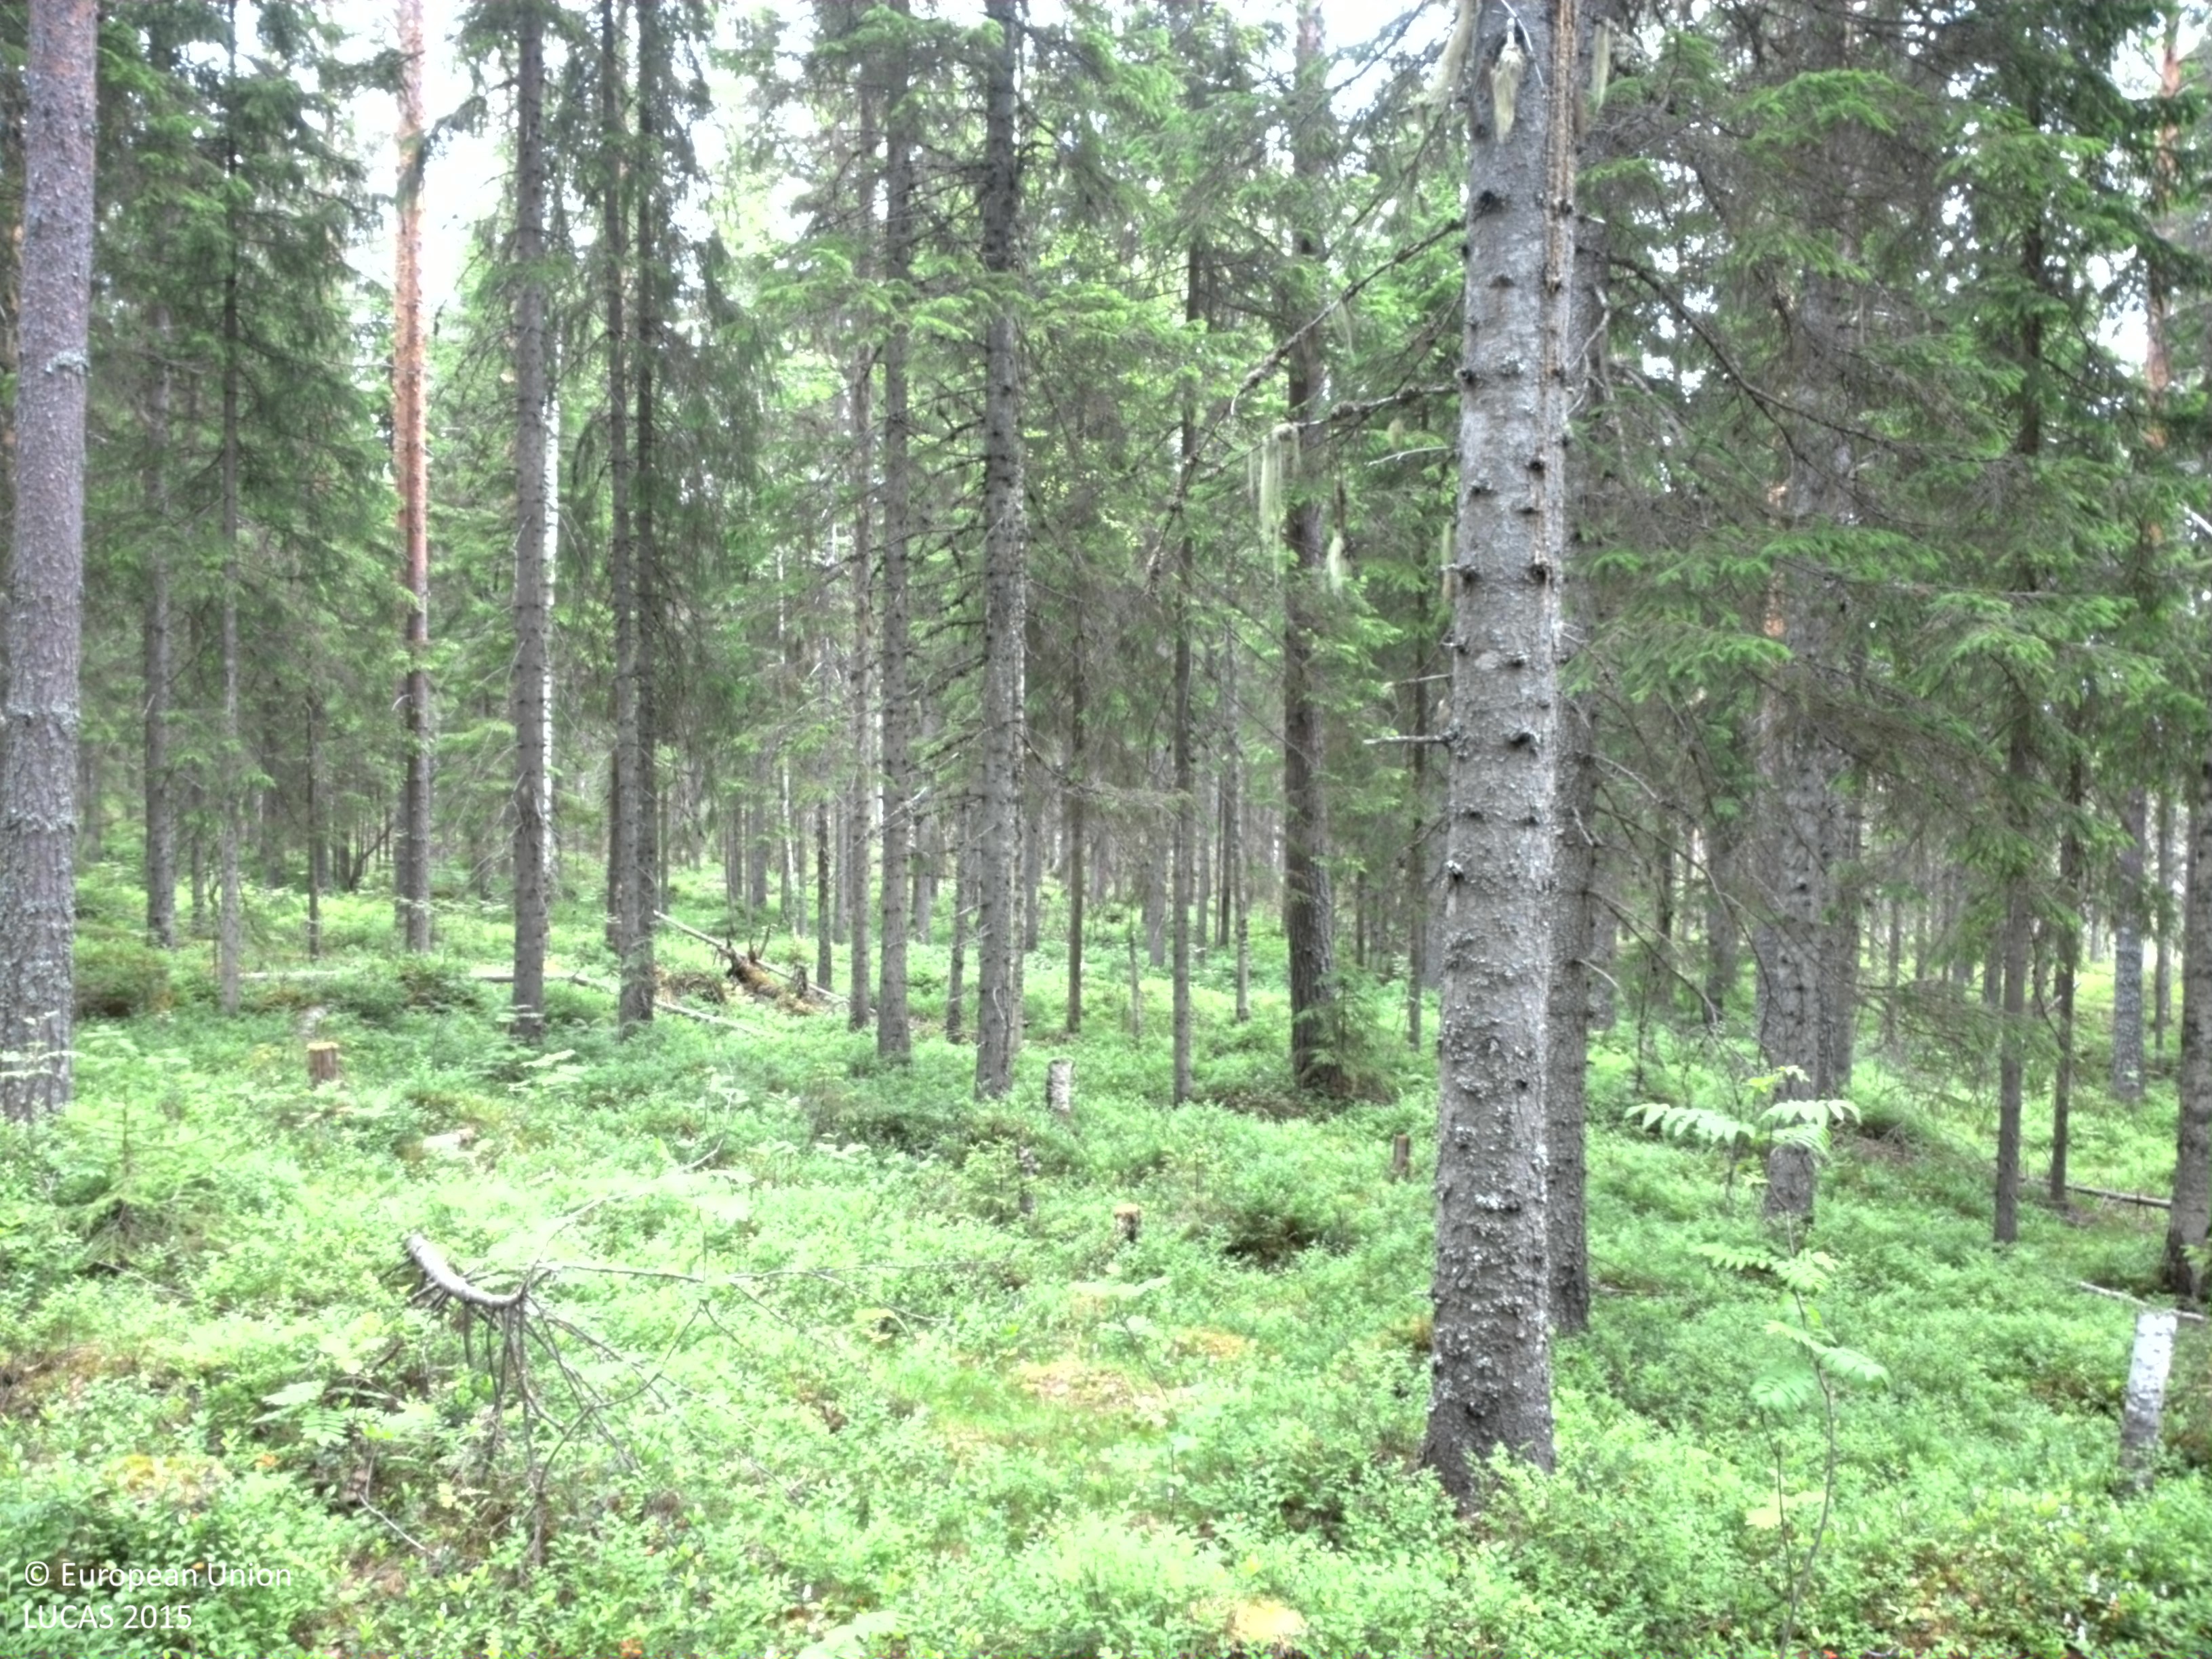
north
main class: Woodland
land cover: Spruce dominated coniferous woodland
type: boreal forest
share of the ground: 50 - 75 %
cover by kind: coniferous forest trees 75 %, shrubs 25 %
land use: Forestry
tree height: > 5 m
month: July
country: SE
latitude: 64.4606
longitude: 20.8944
